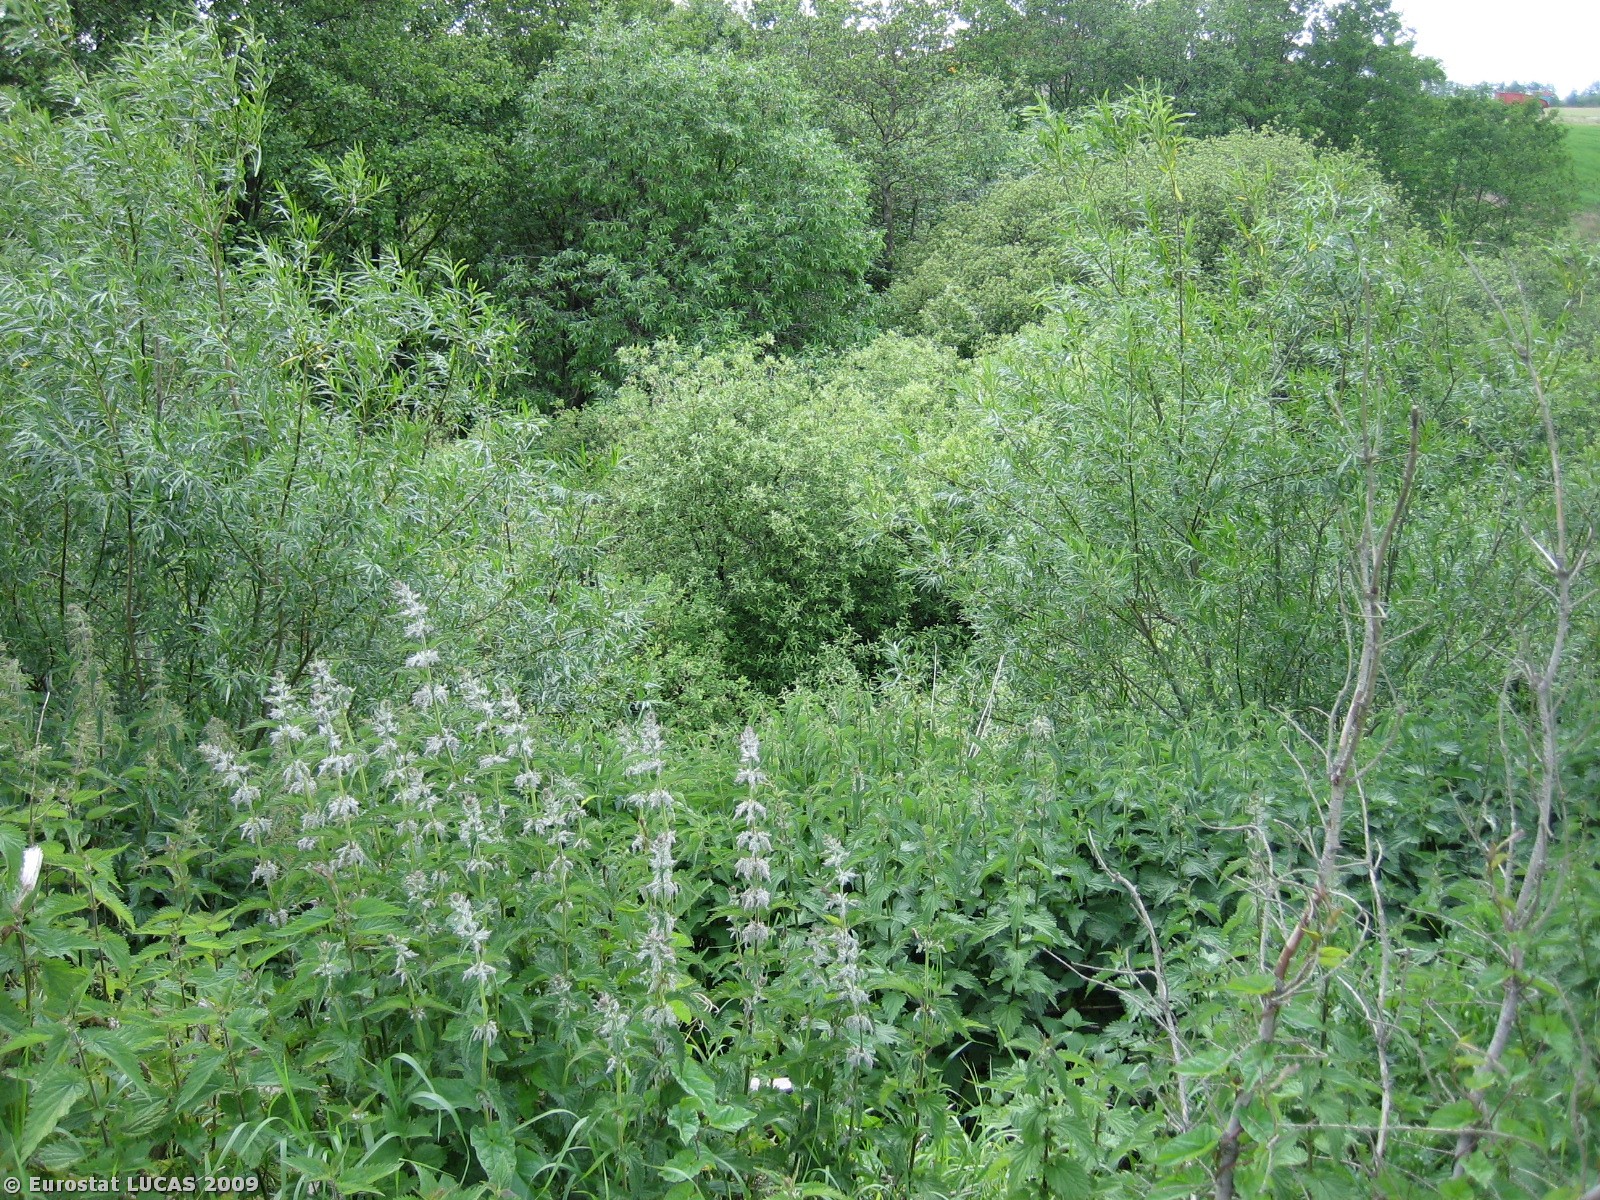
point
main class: Woodland
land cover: Broadleaved woodland
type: mesophytic deciduous forest
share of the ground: > 75 %
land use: Forestry
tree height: > 5 m
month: June
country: DK
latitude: 55.6102
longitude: 9.2229
